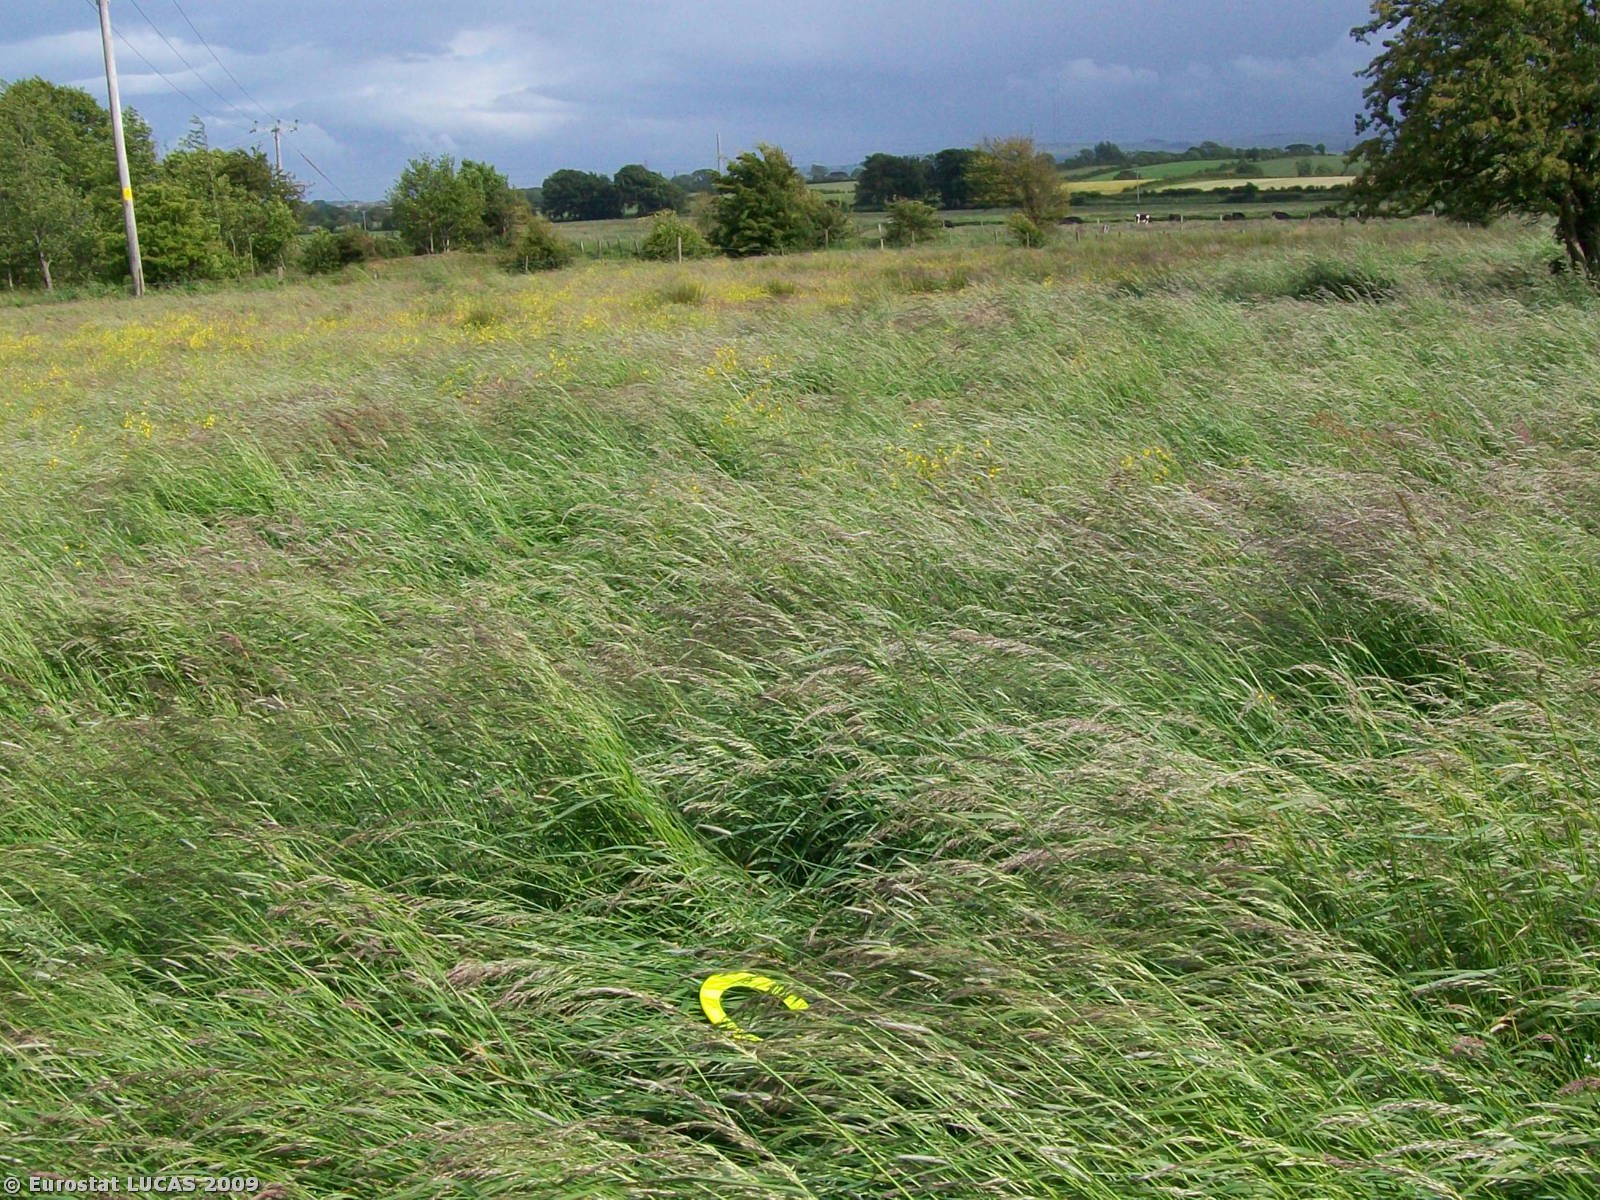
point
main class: Grassland
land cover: Grassland without tree/shrub cover
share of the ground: > 75 %
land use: Agriculture (excluding fallow land and kitchen gardens)
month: June
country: GB
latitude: 54.8448
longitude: -3.2033
